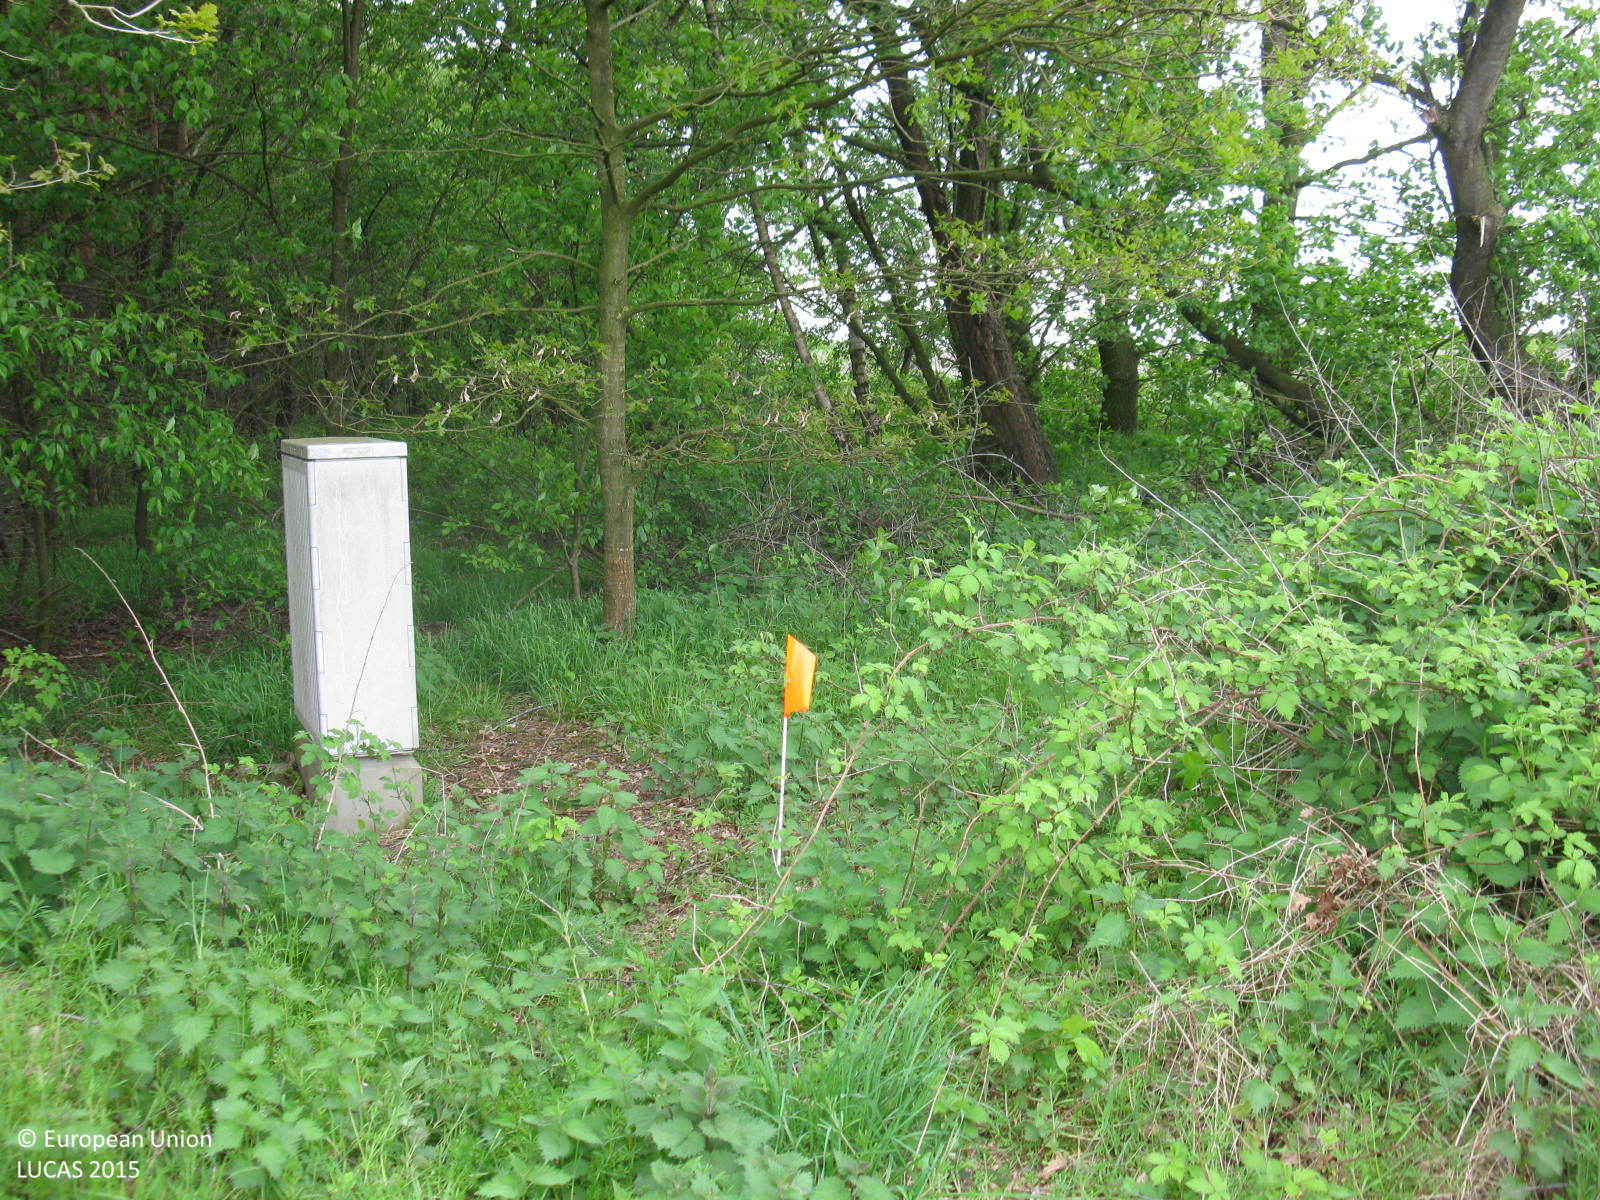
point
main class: Grassland
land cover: Spontaneously vegetated surfaces
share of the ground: > 75 %
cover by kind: herbaceous plants 100 %
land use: Semi-natural and natural areas not in use
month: May
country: DE
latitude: 52.7974
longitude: 7.3456
